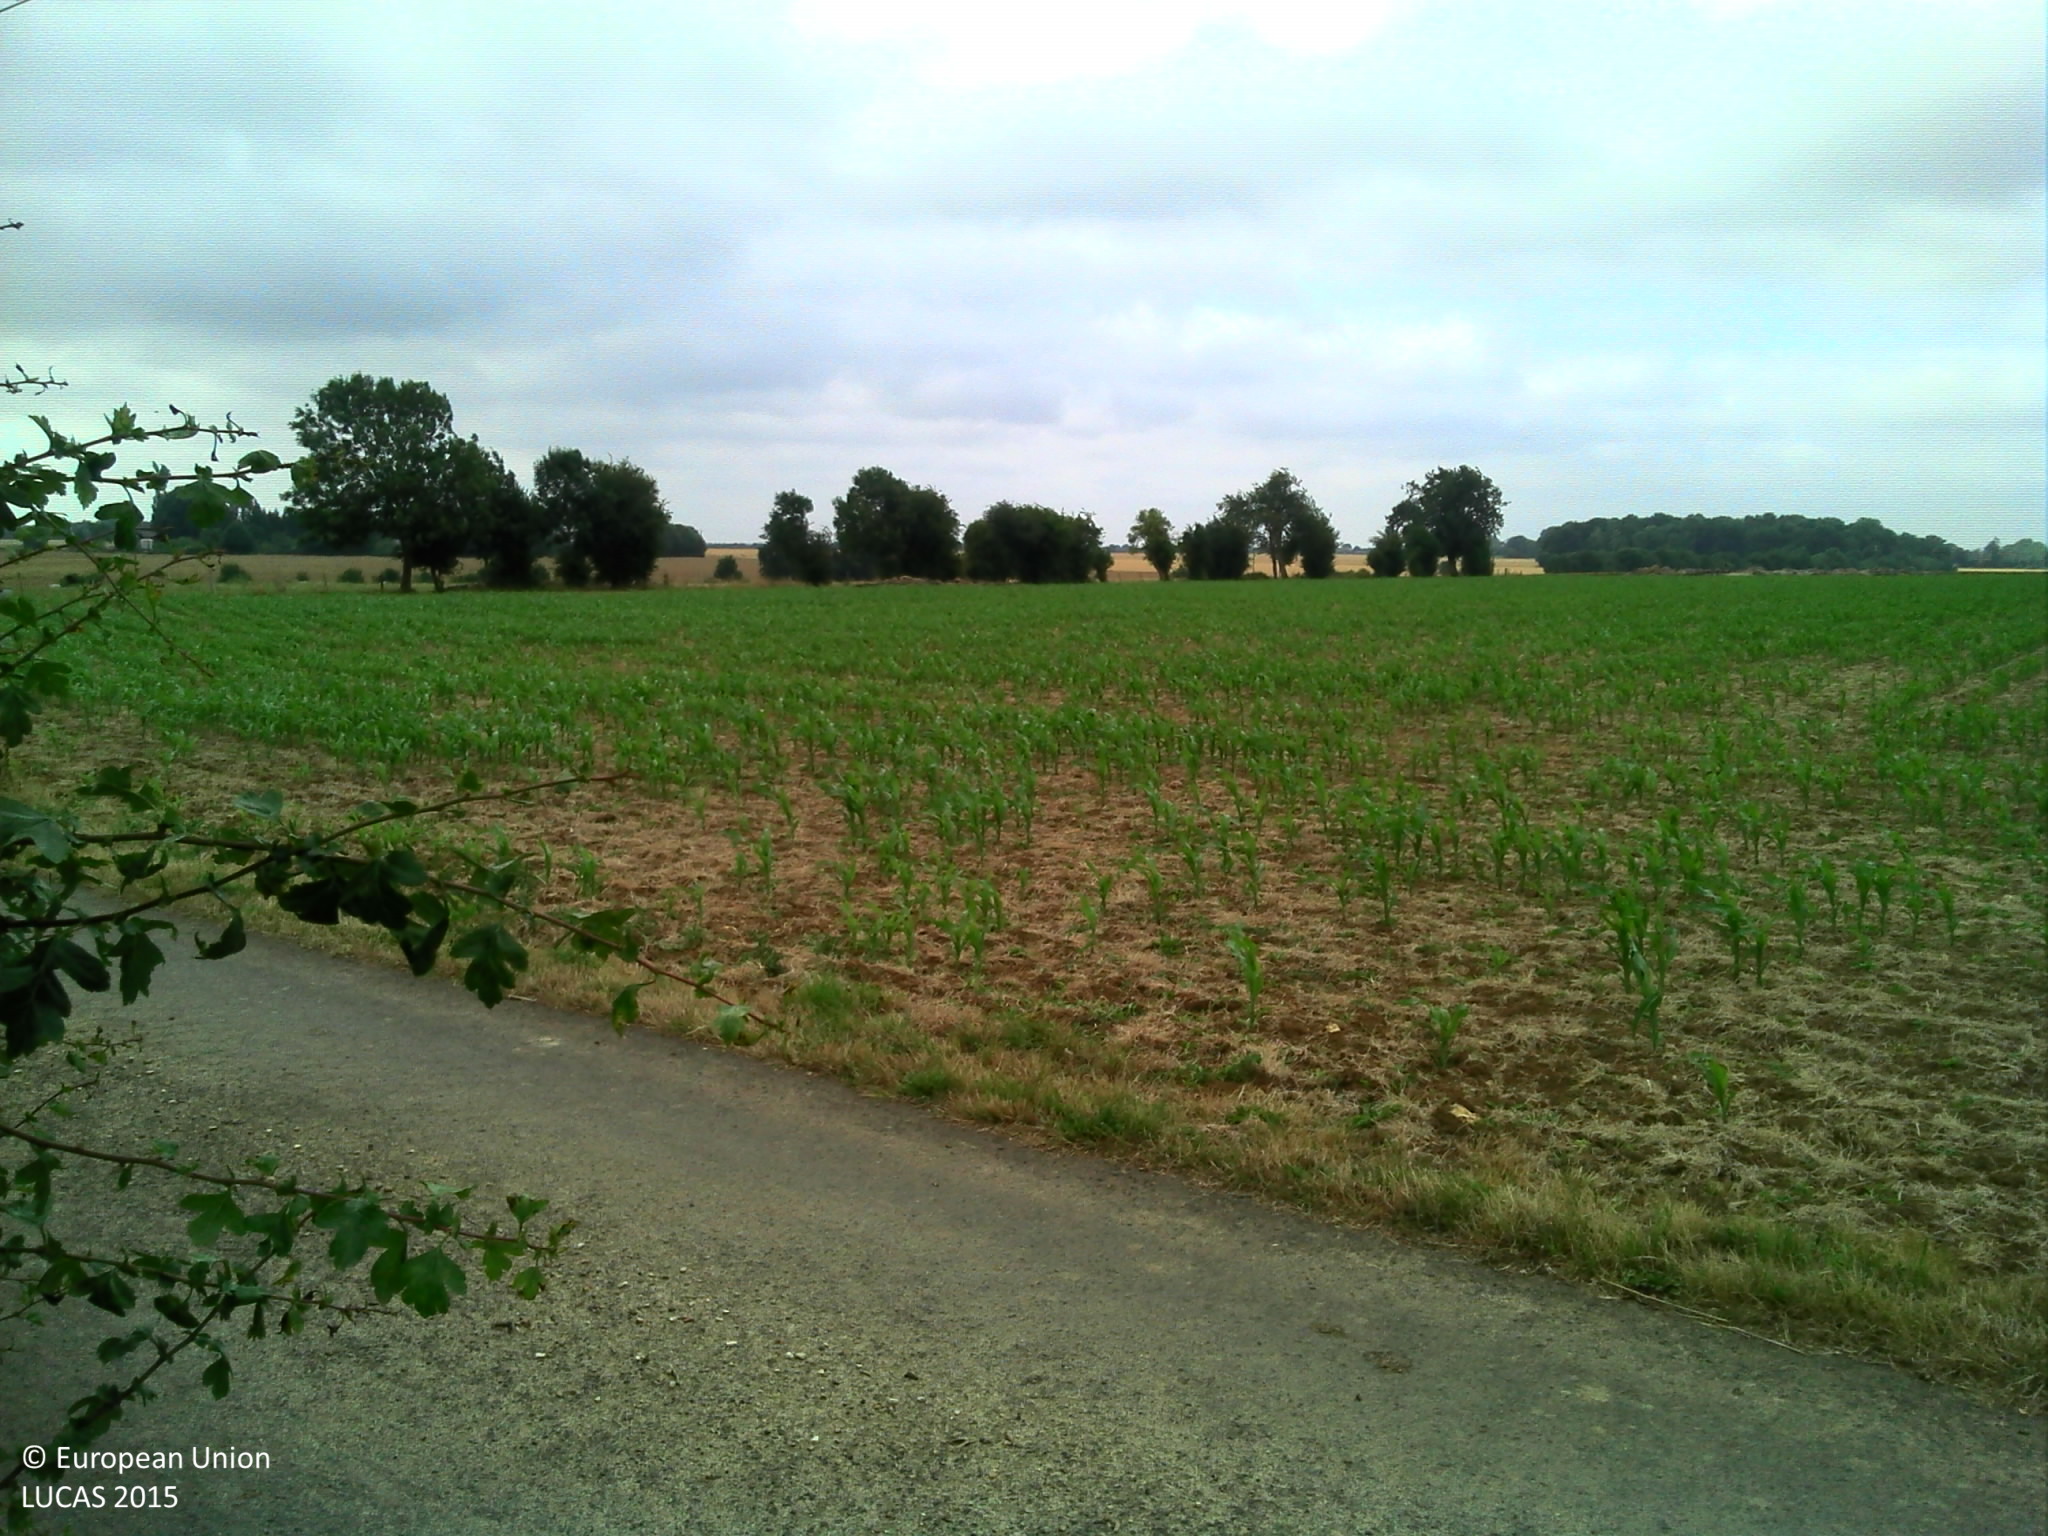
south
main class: Cropland
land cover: Maize
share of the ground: > 75 %
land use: Agriculture (excluding fallow land and kitchen gardens)
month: July
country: FR
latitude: 48.9120
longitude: 0.4360
